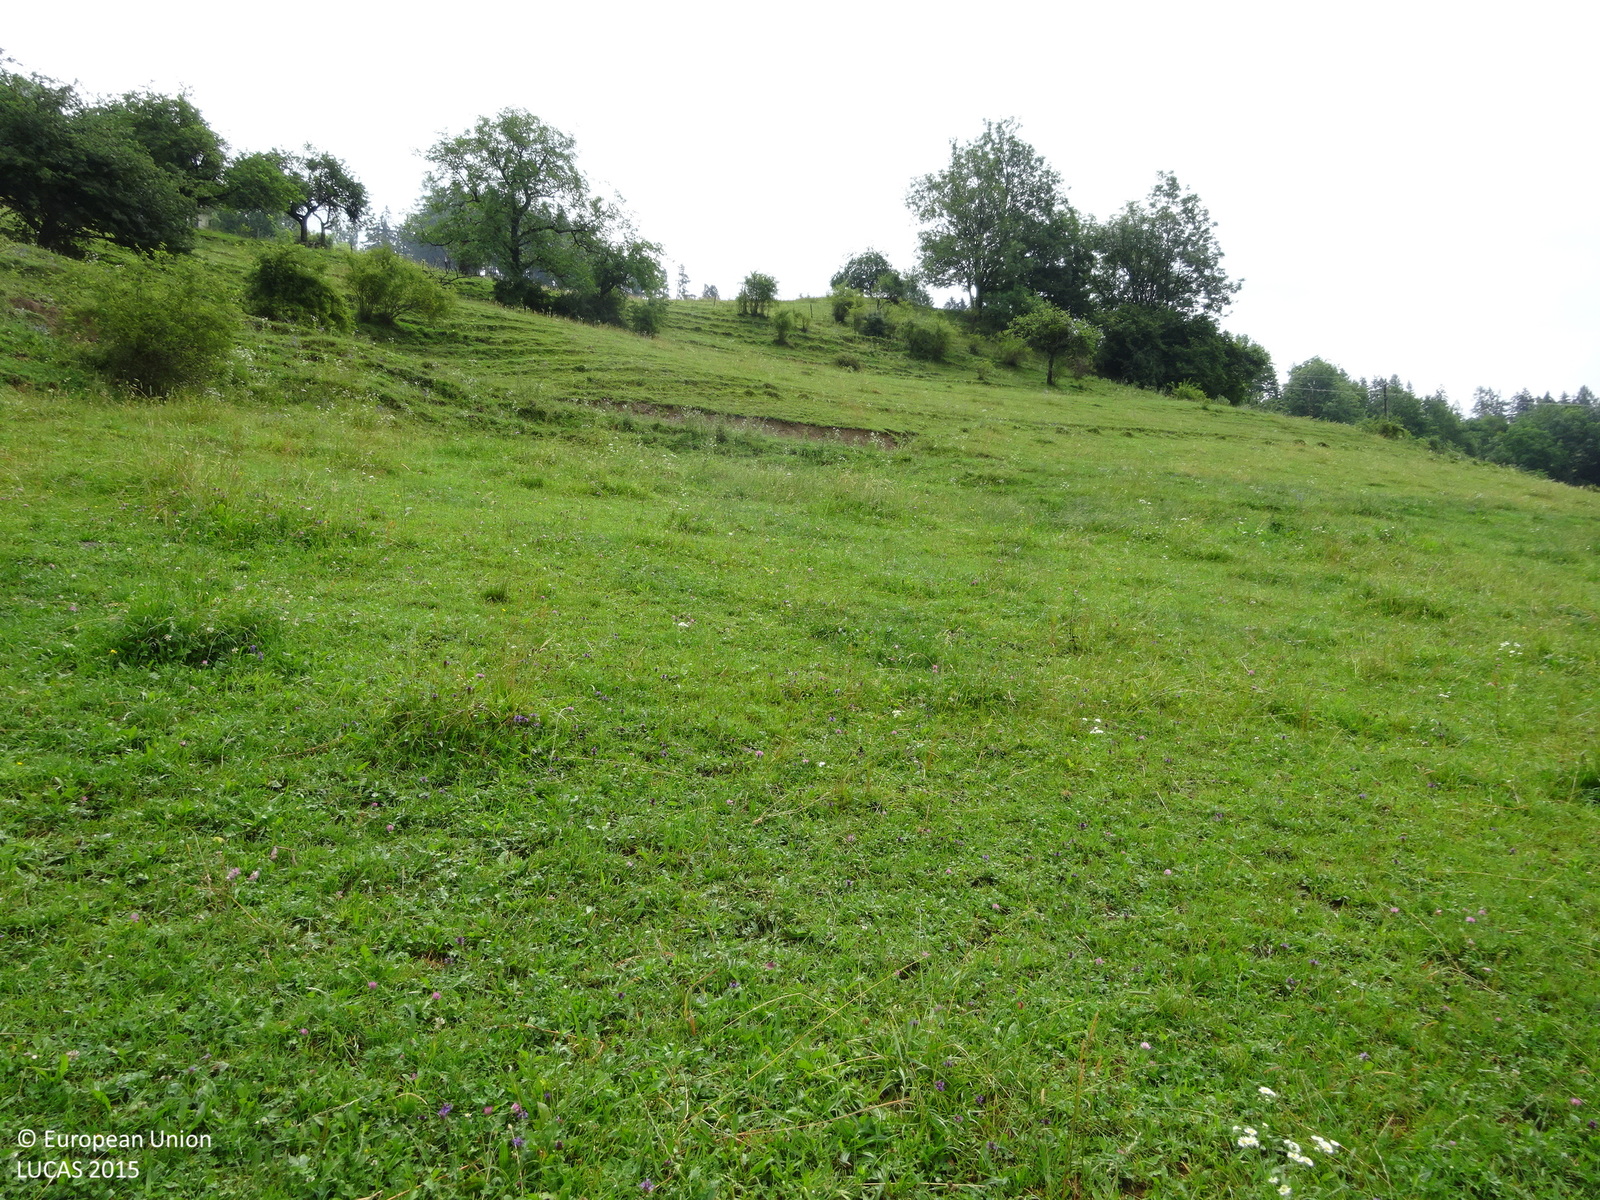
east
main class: Grassland
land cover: Grassland without tree/shrub cover
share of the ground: > 75 %
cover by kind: herbaceous plants 100 %
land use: Agriculture (excluding fallow land and kitchen gardens)
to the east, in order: Grassland without tree/shrub cover; Tracks; Grassland without tree/shrub cover; Grassland with sparse tree/shrub cover; Fences; Grassland without tree/shrub cover; Fences; Grassland with sparse tree/shrub cover; Fences; Paved roads, cycling and walking lanes; Grassland without tree/shrub cover; Paved roads, cycling and walking lanes; Grass margins; Fences; Grassland with sparse tree/shrub cover; Grassland without tree/shrub cover
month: July
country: AT
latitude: 47.1304
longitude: 15.1277
